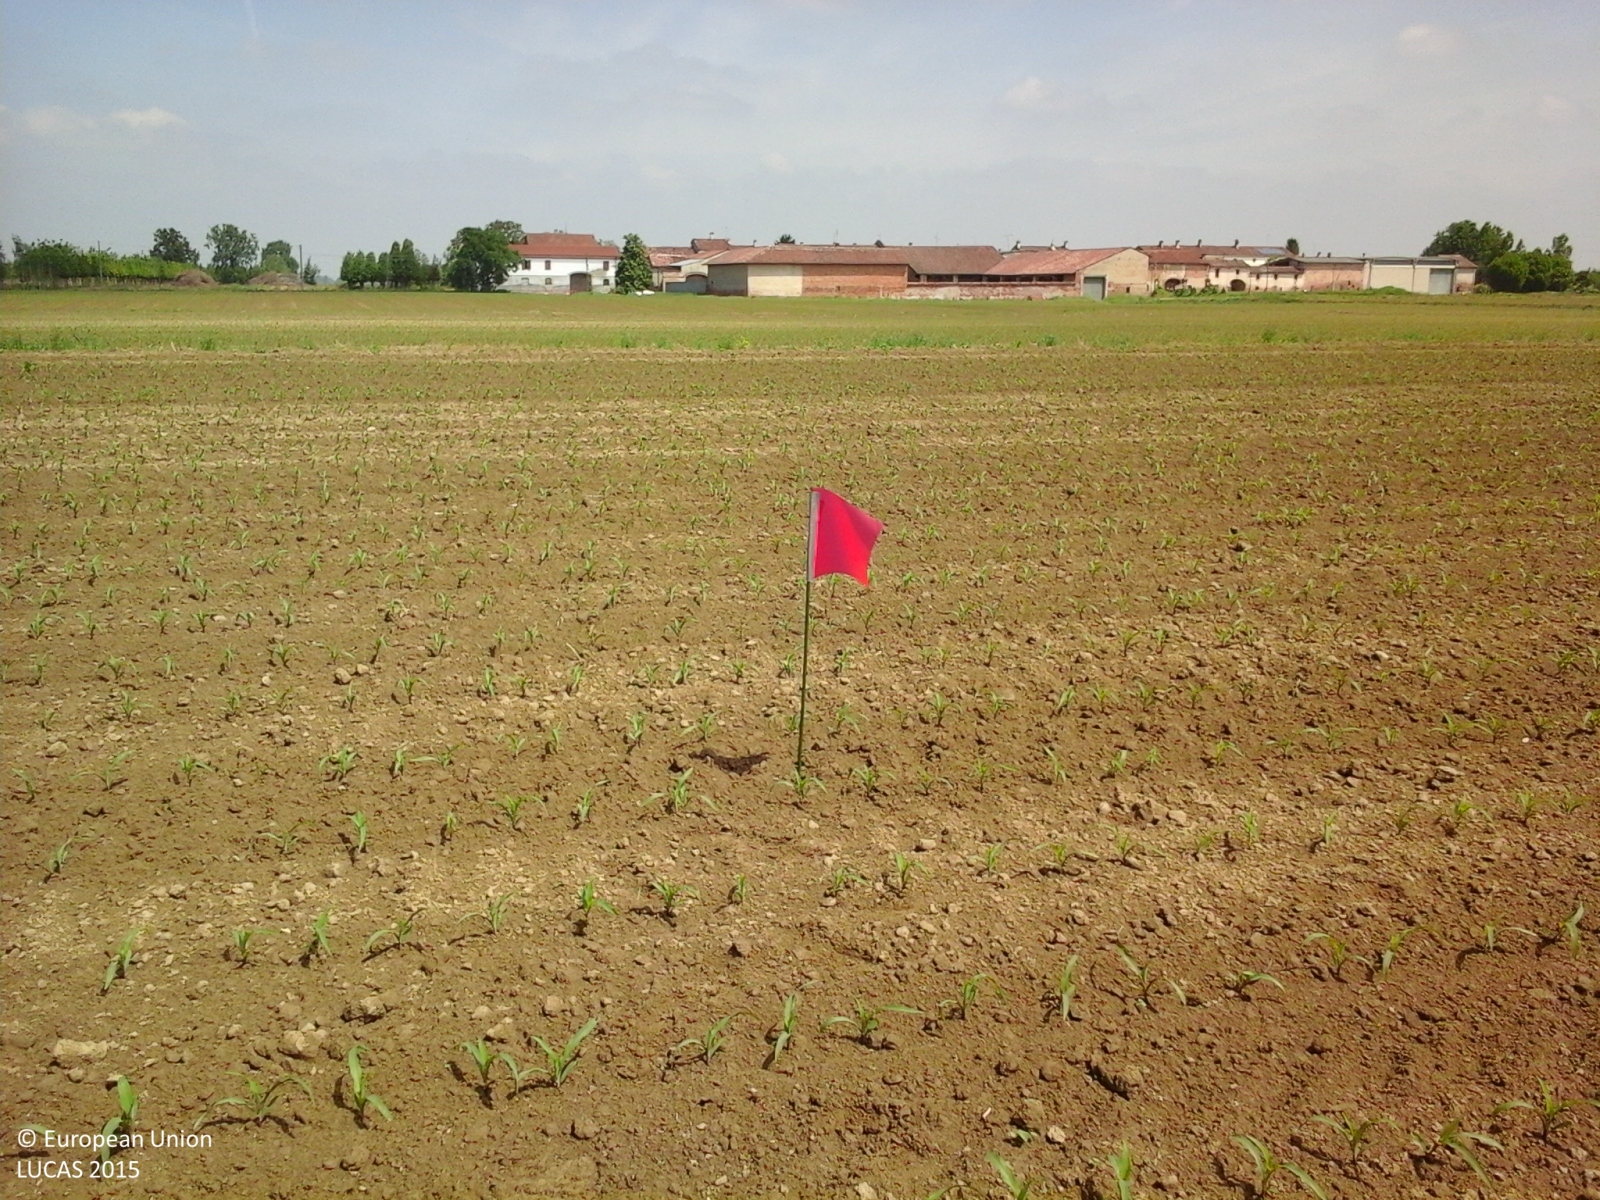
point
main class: Cropland
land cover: Maize
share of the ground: < 10 %
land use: Agriculture (excluding fallow land and kitchen gardens)
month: May
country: IT
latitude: 45.1255
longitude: 10.2919
